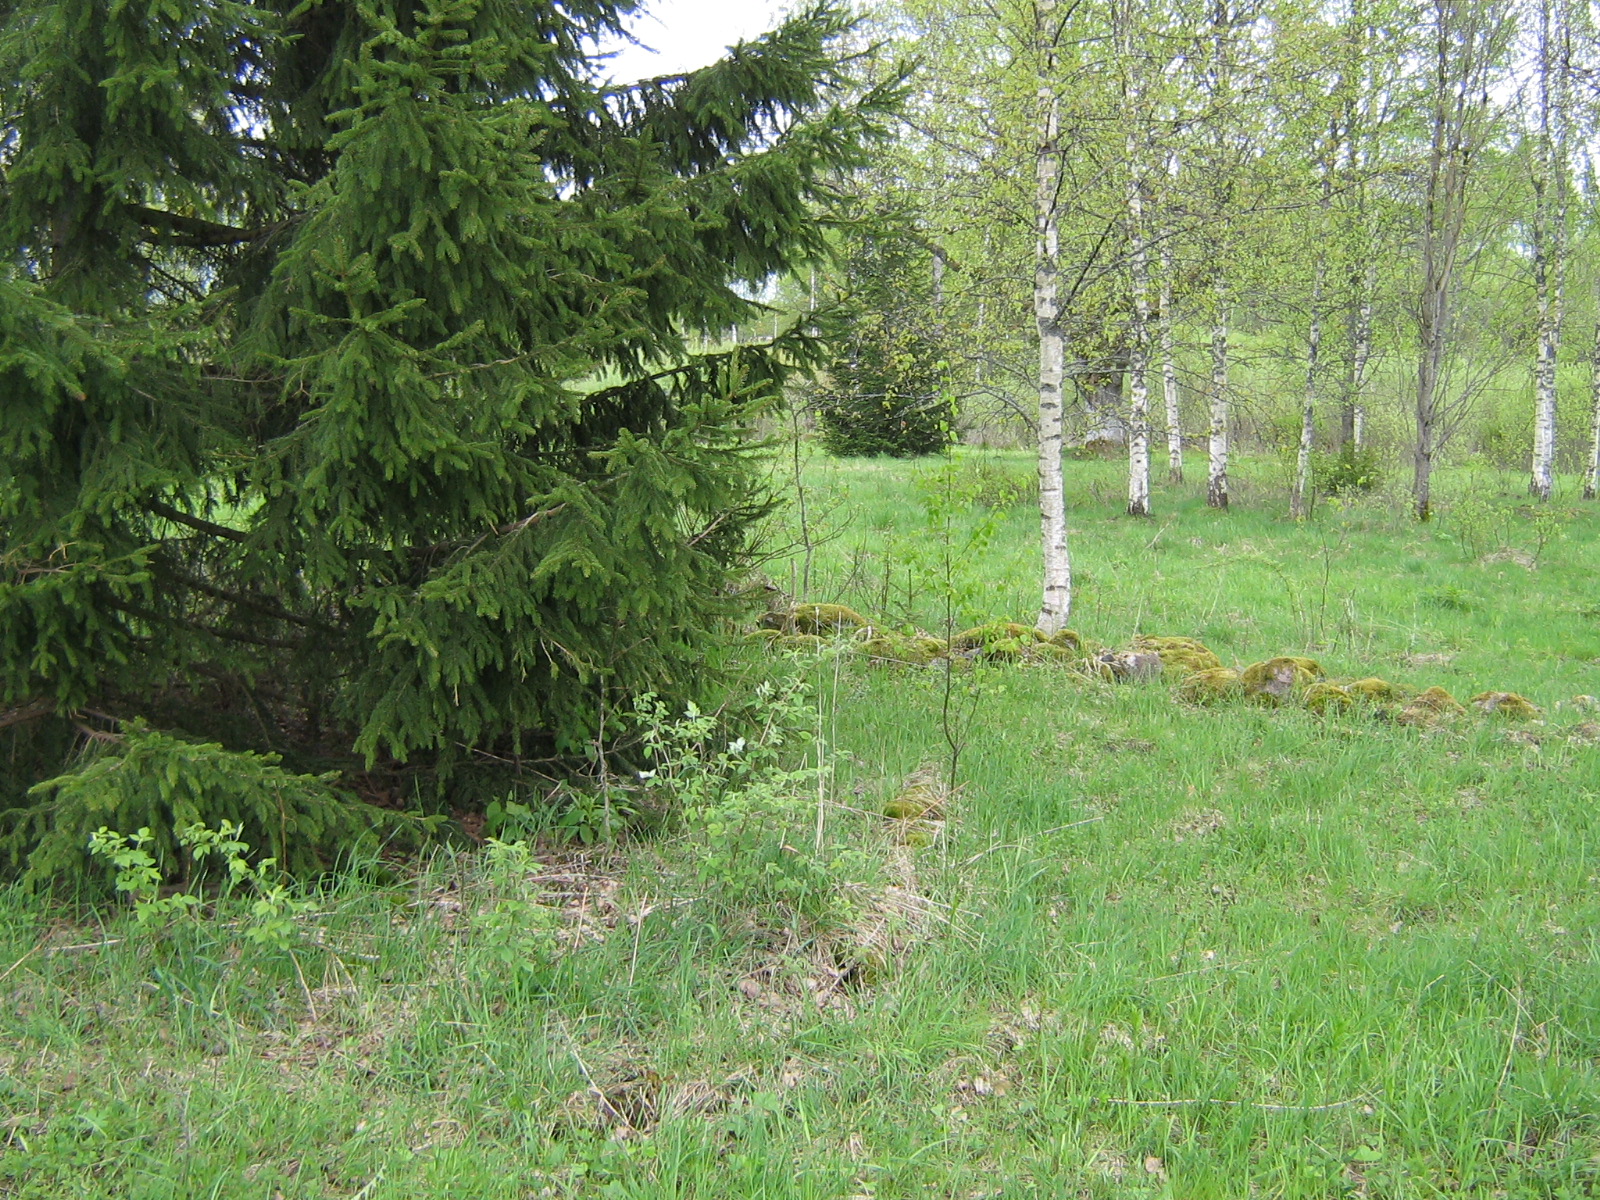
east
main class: Woodland
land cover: Spruce dominated mixed woodland
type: hemiboreal forest and nemoral coniferous forest and mixed broadleaved-coniferous forest
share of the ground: > 75 %
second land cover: Grassland without tree/shrub cover
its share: > 75 %
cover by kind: broadleaved forest trees 55 %, coniferous forest trees 30 %, herbaceous plants 15 %
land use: Agriculture (excluding fallow land and kitchen gardens)
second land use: Forestry
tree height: > 5 m
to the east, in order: Spruce dominated mixed woodland; Grassland without tree/shrub cover; Dry stone walls; Grassland without tree/shrub cover; Broadleaved woodland; Lines of trees; Grassland with sparse tree/shrub cover; Single bushes/trees; Grassland without tree/shrub cover
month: May
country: LV
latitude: 57.1111
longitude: 25.4895
